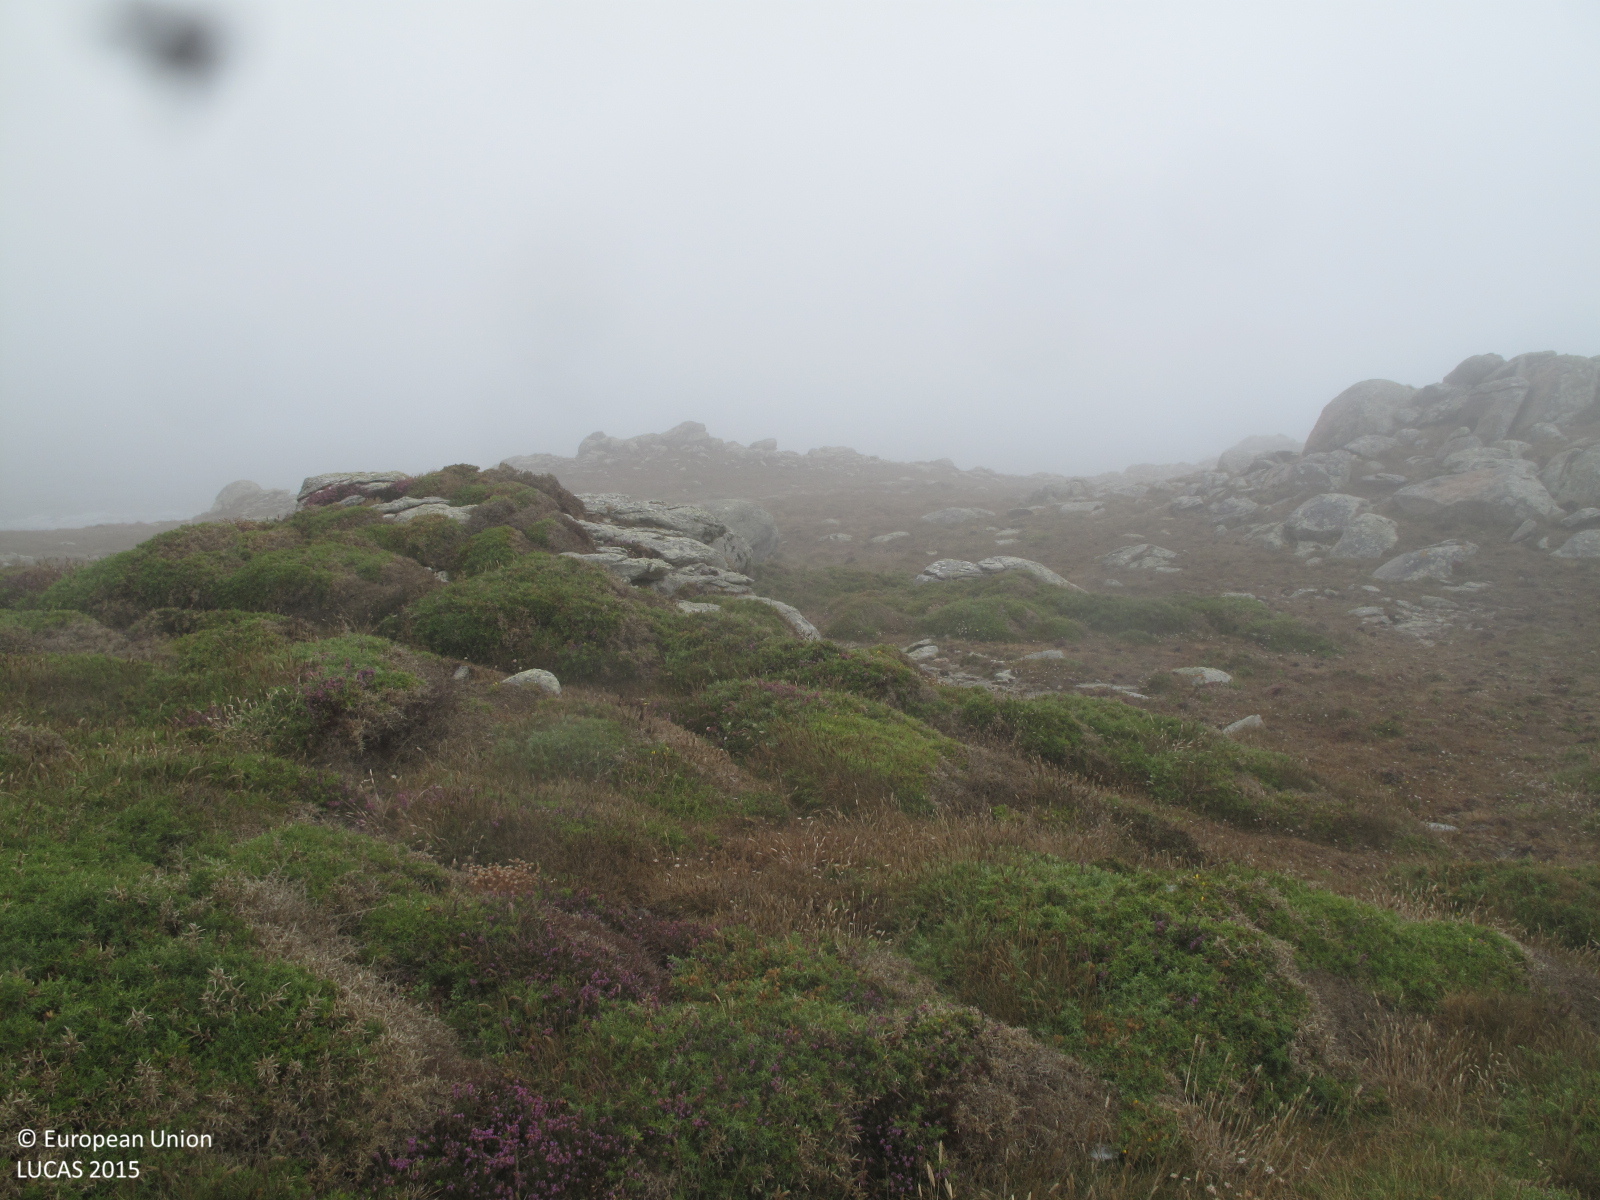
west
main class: Shrubland
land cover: Shrubland without tree cover
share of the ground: 50 - 75 %
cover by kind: shrubs 70 %, herbaceous plants 10 %, lichens and mosses 10 %, consolidated bare surface 10 %
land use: Semi-natural and natural areas not in use
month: July
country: ES
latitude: 43.0544
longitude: -9.2973
